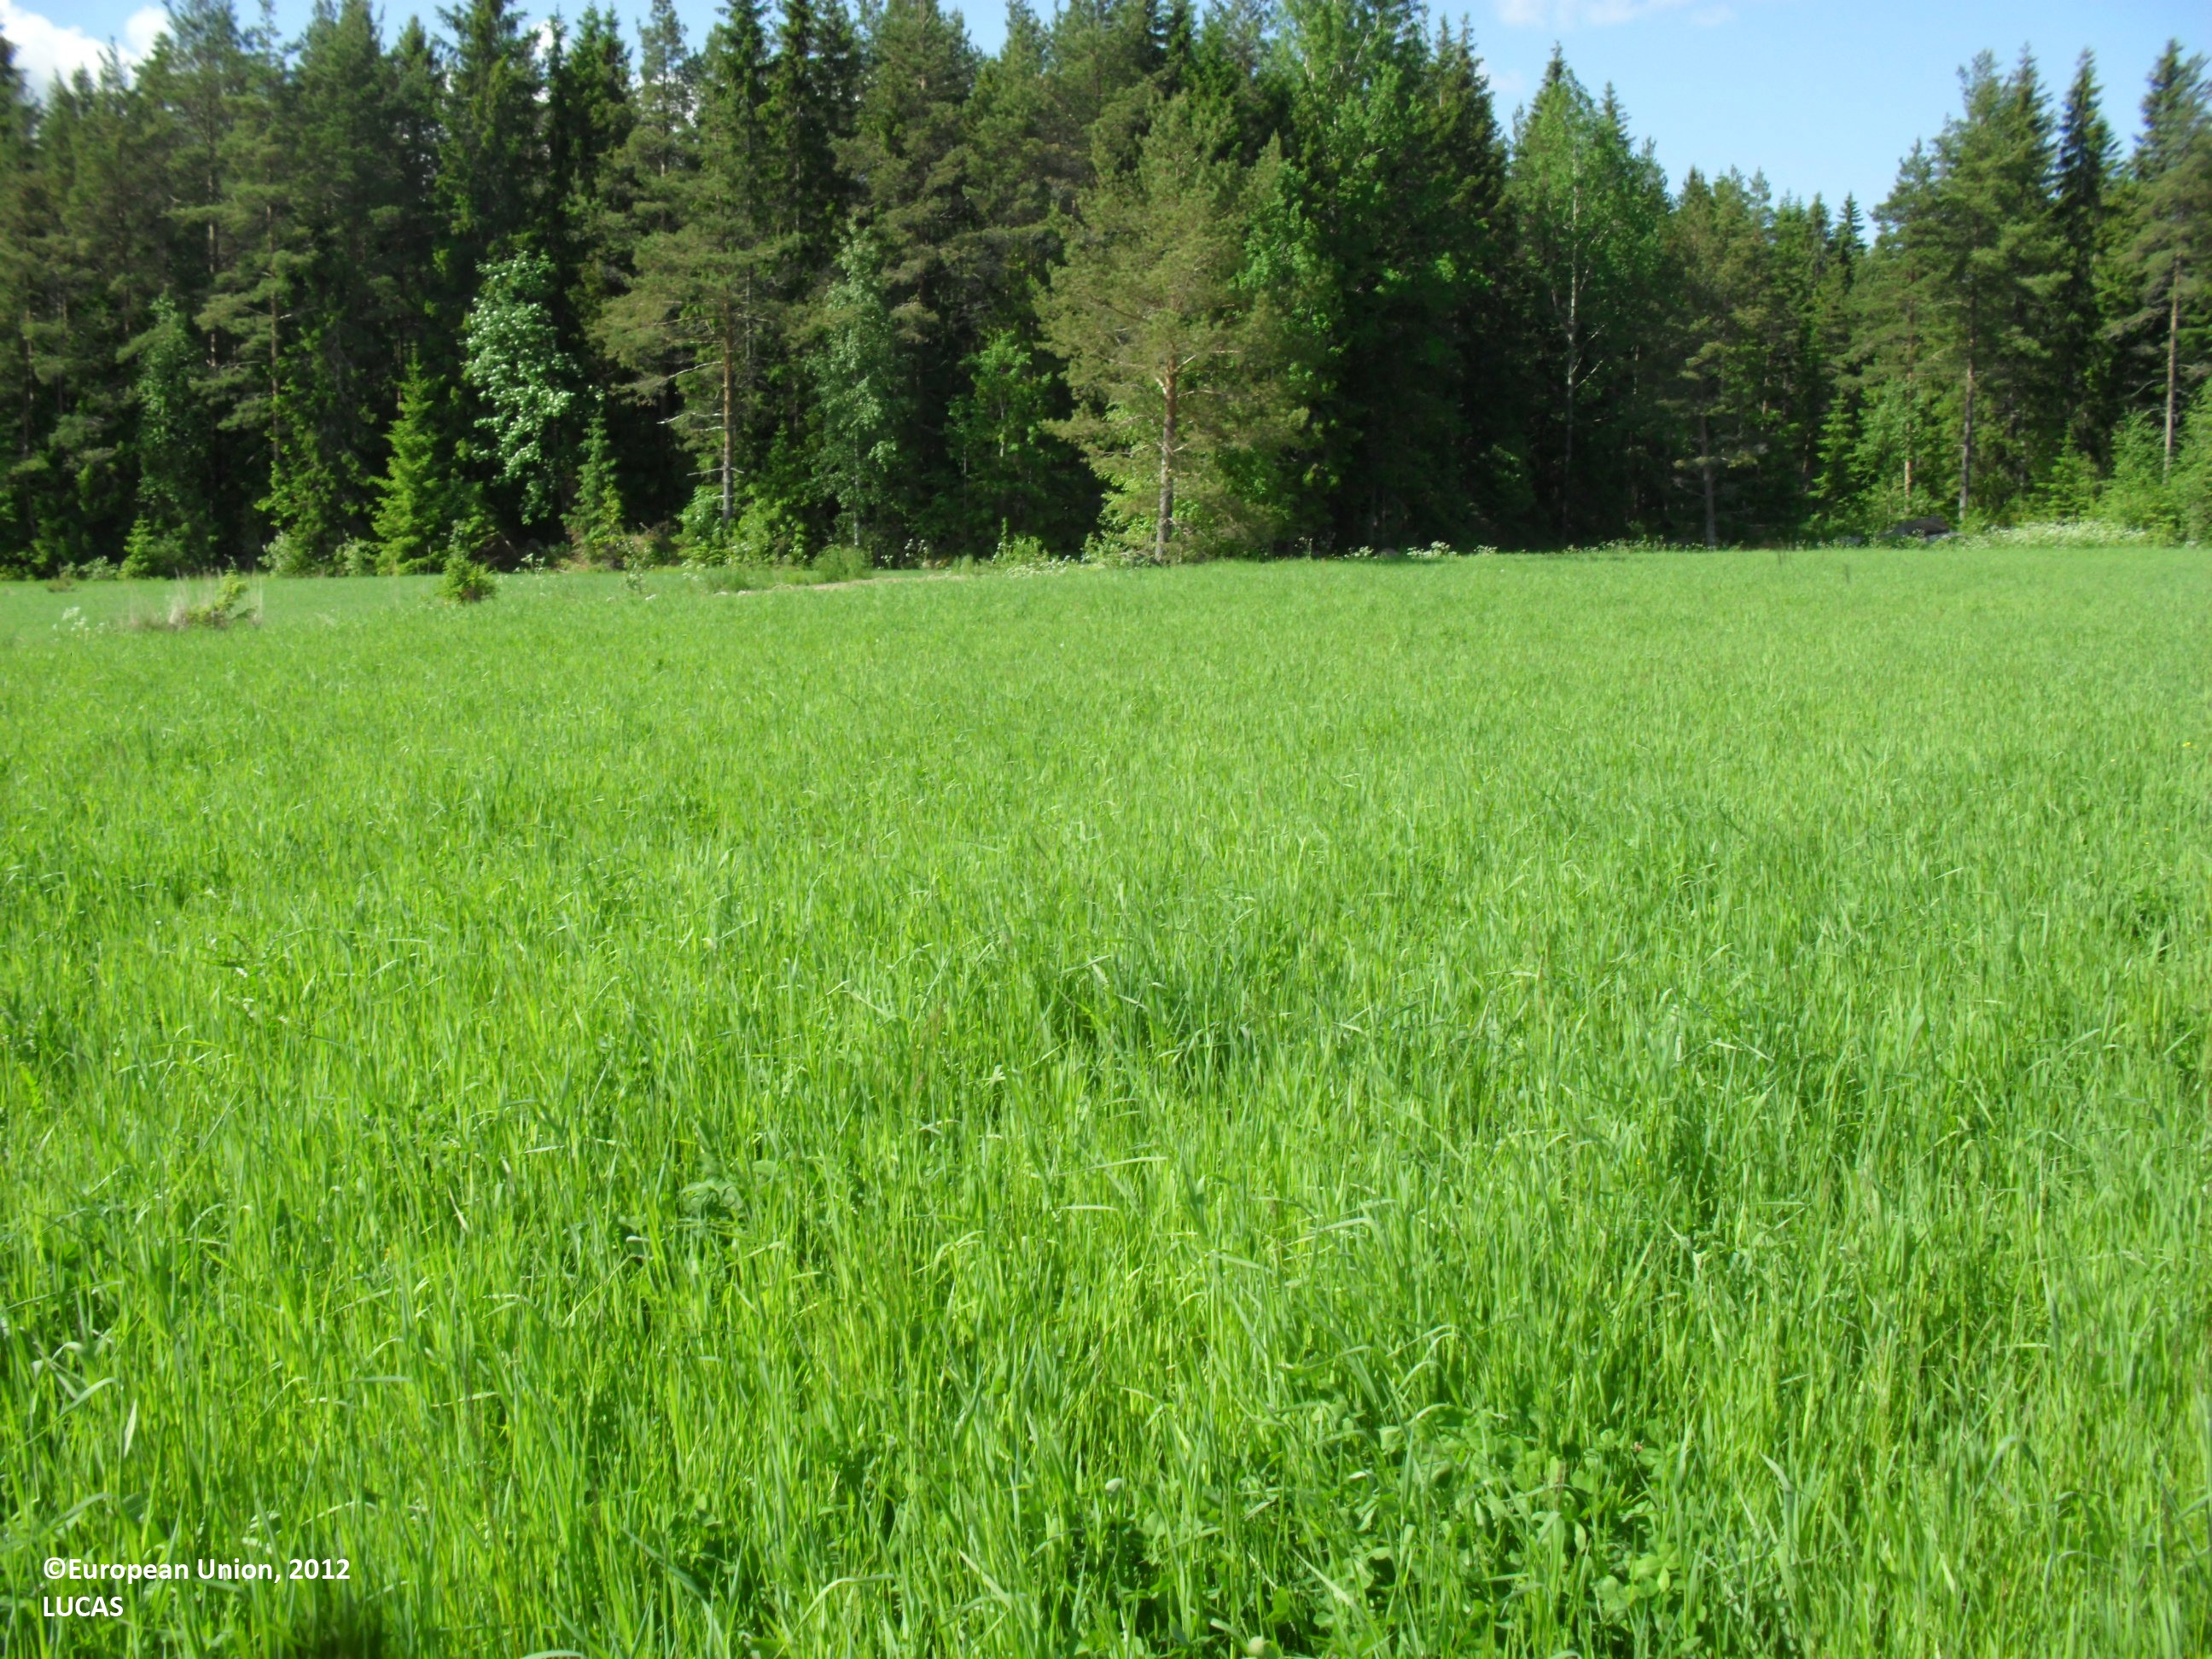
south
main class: Cropland
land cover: Temporary grasslands
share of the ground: > 75 %
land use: Agriculture (excluding fallow land and kitchen gardens)
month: June
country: FI
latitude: 62.9685
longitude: 23.1371
